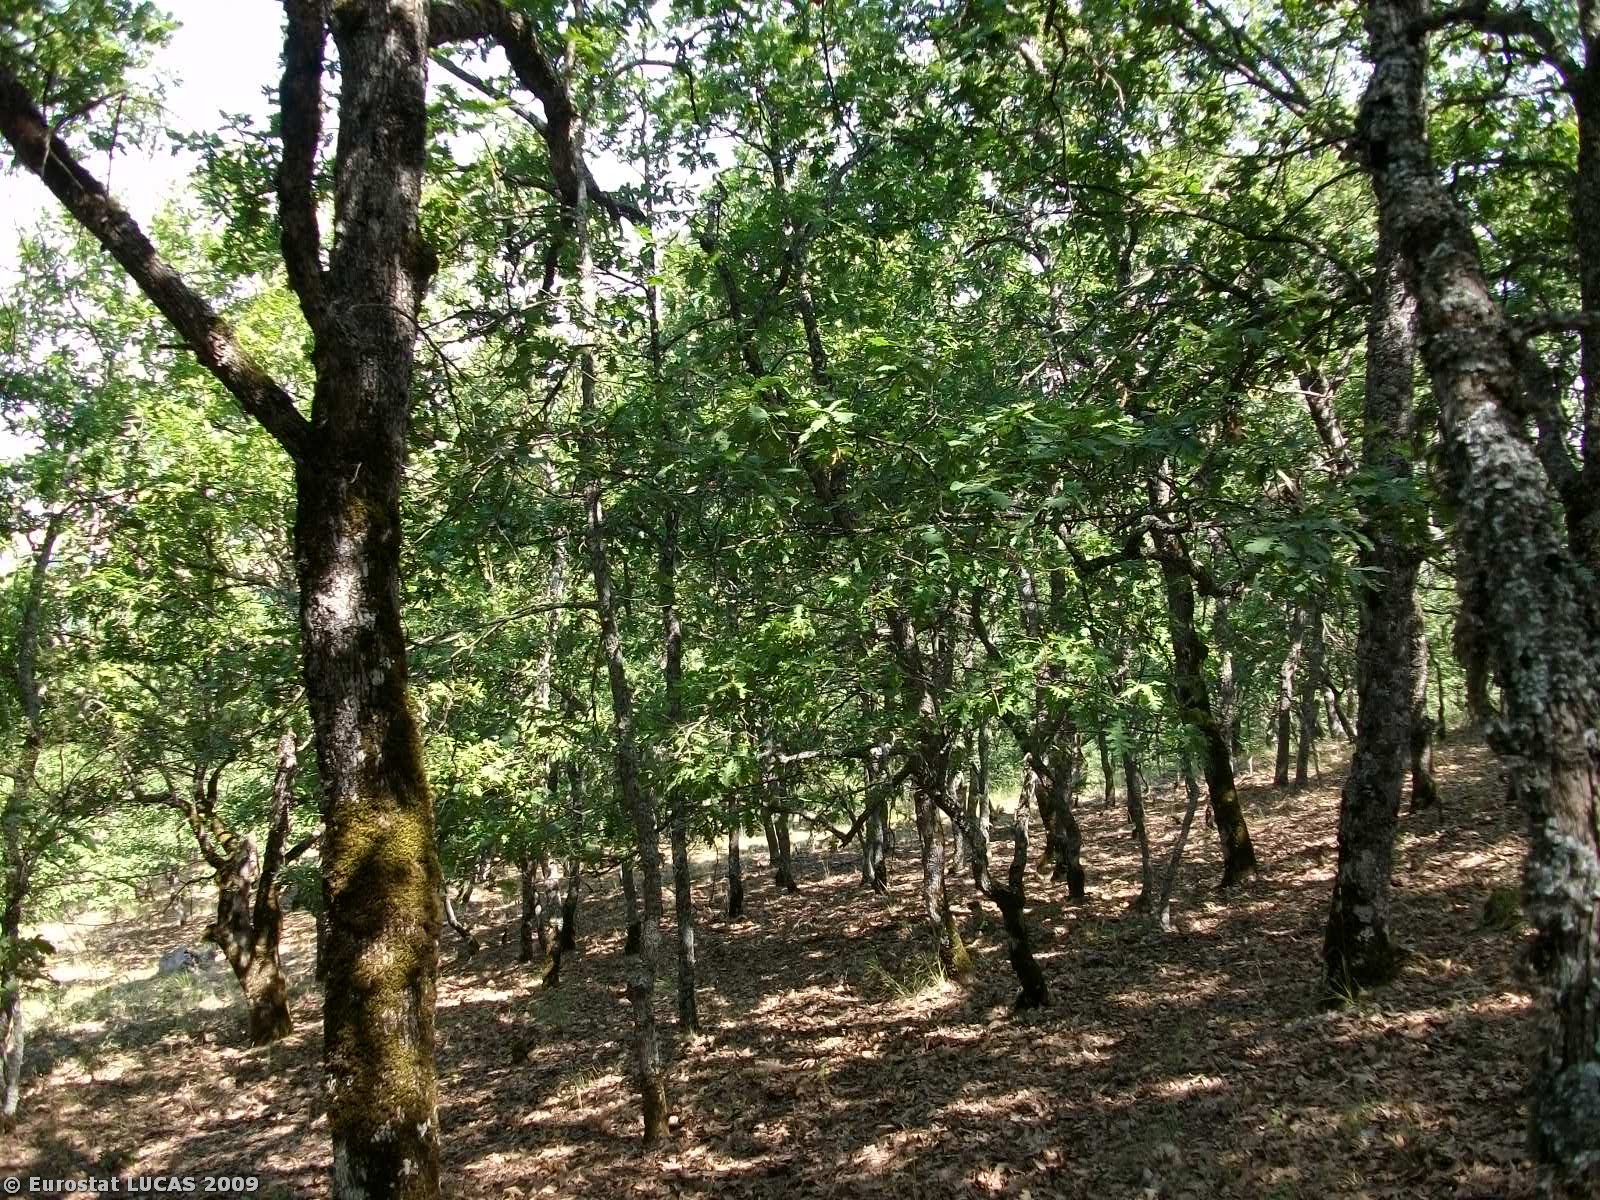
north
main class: Woodland
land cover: Broadleaved woodland
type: thermophilous deciduous forest
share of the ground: > 75 %
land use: Forestry
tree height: > 5 m
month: July
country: GR
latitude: 39.7898
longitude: 21.6510
